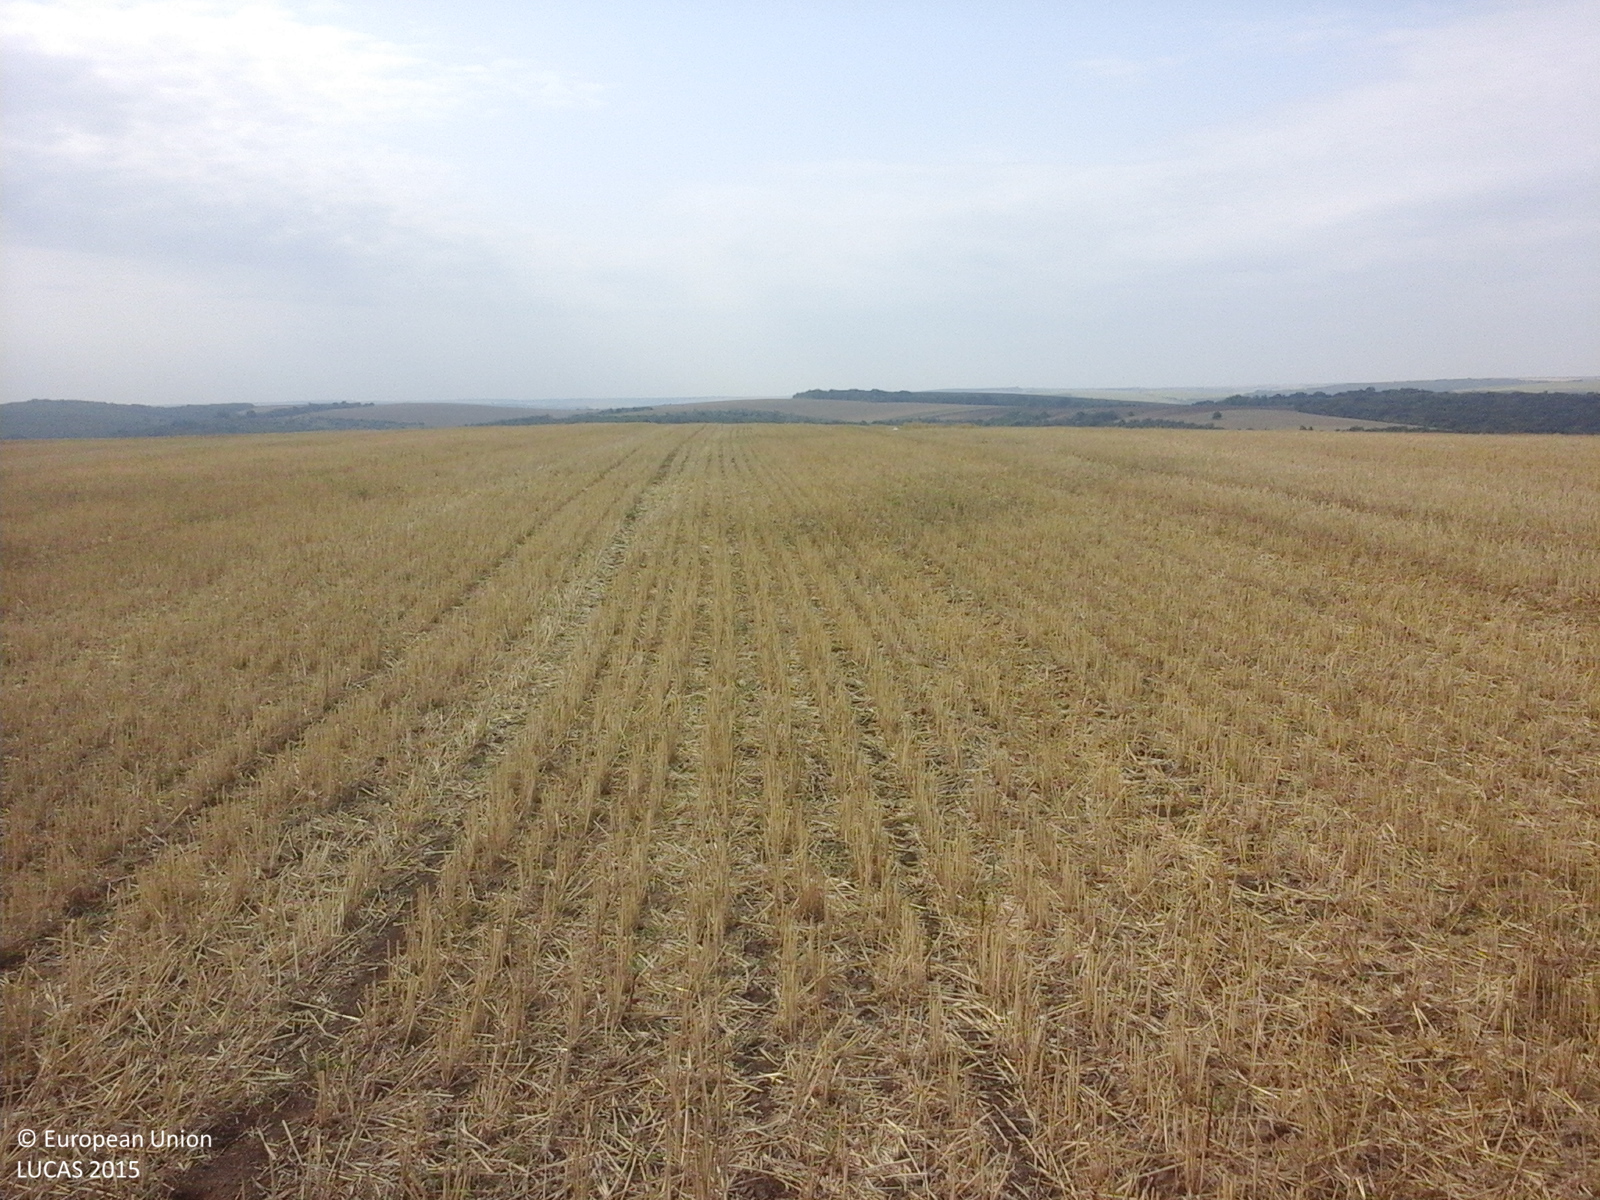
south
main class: Cropland
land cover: Common wheat
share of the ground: 50 - 75 %
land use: Agriculture (excluding fallow land and kitchen gardens)
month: August
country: RO
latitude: 44.1010
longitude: 27.8241
